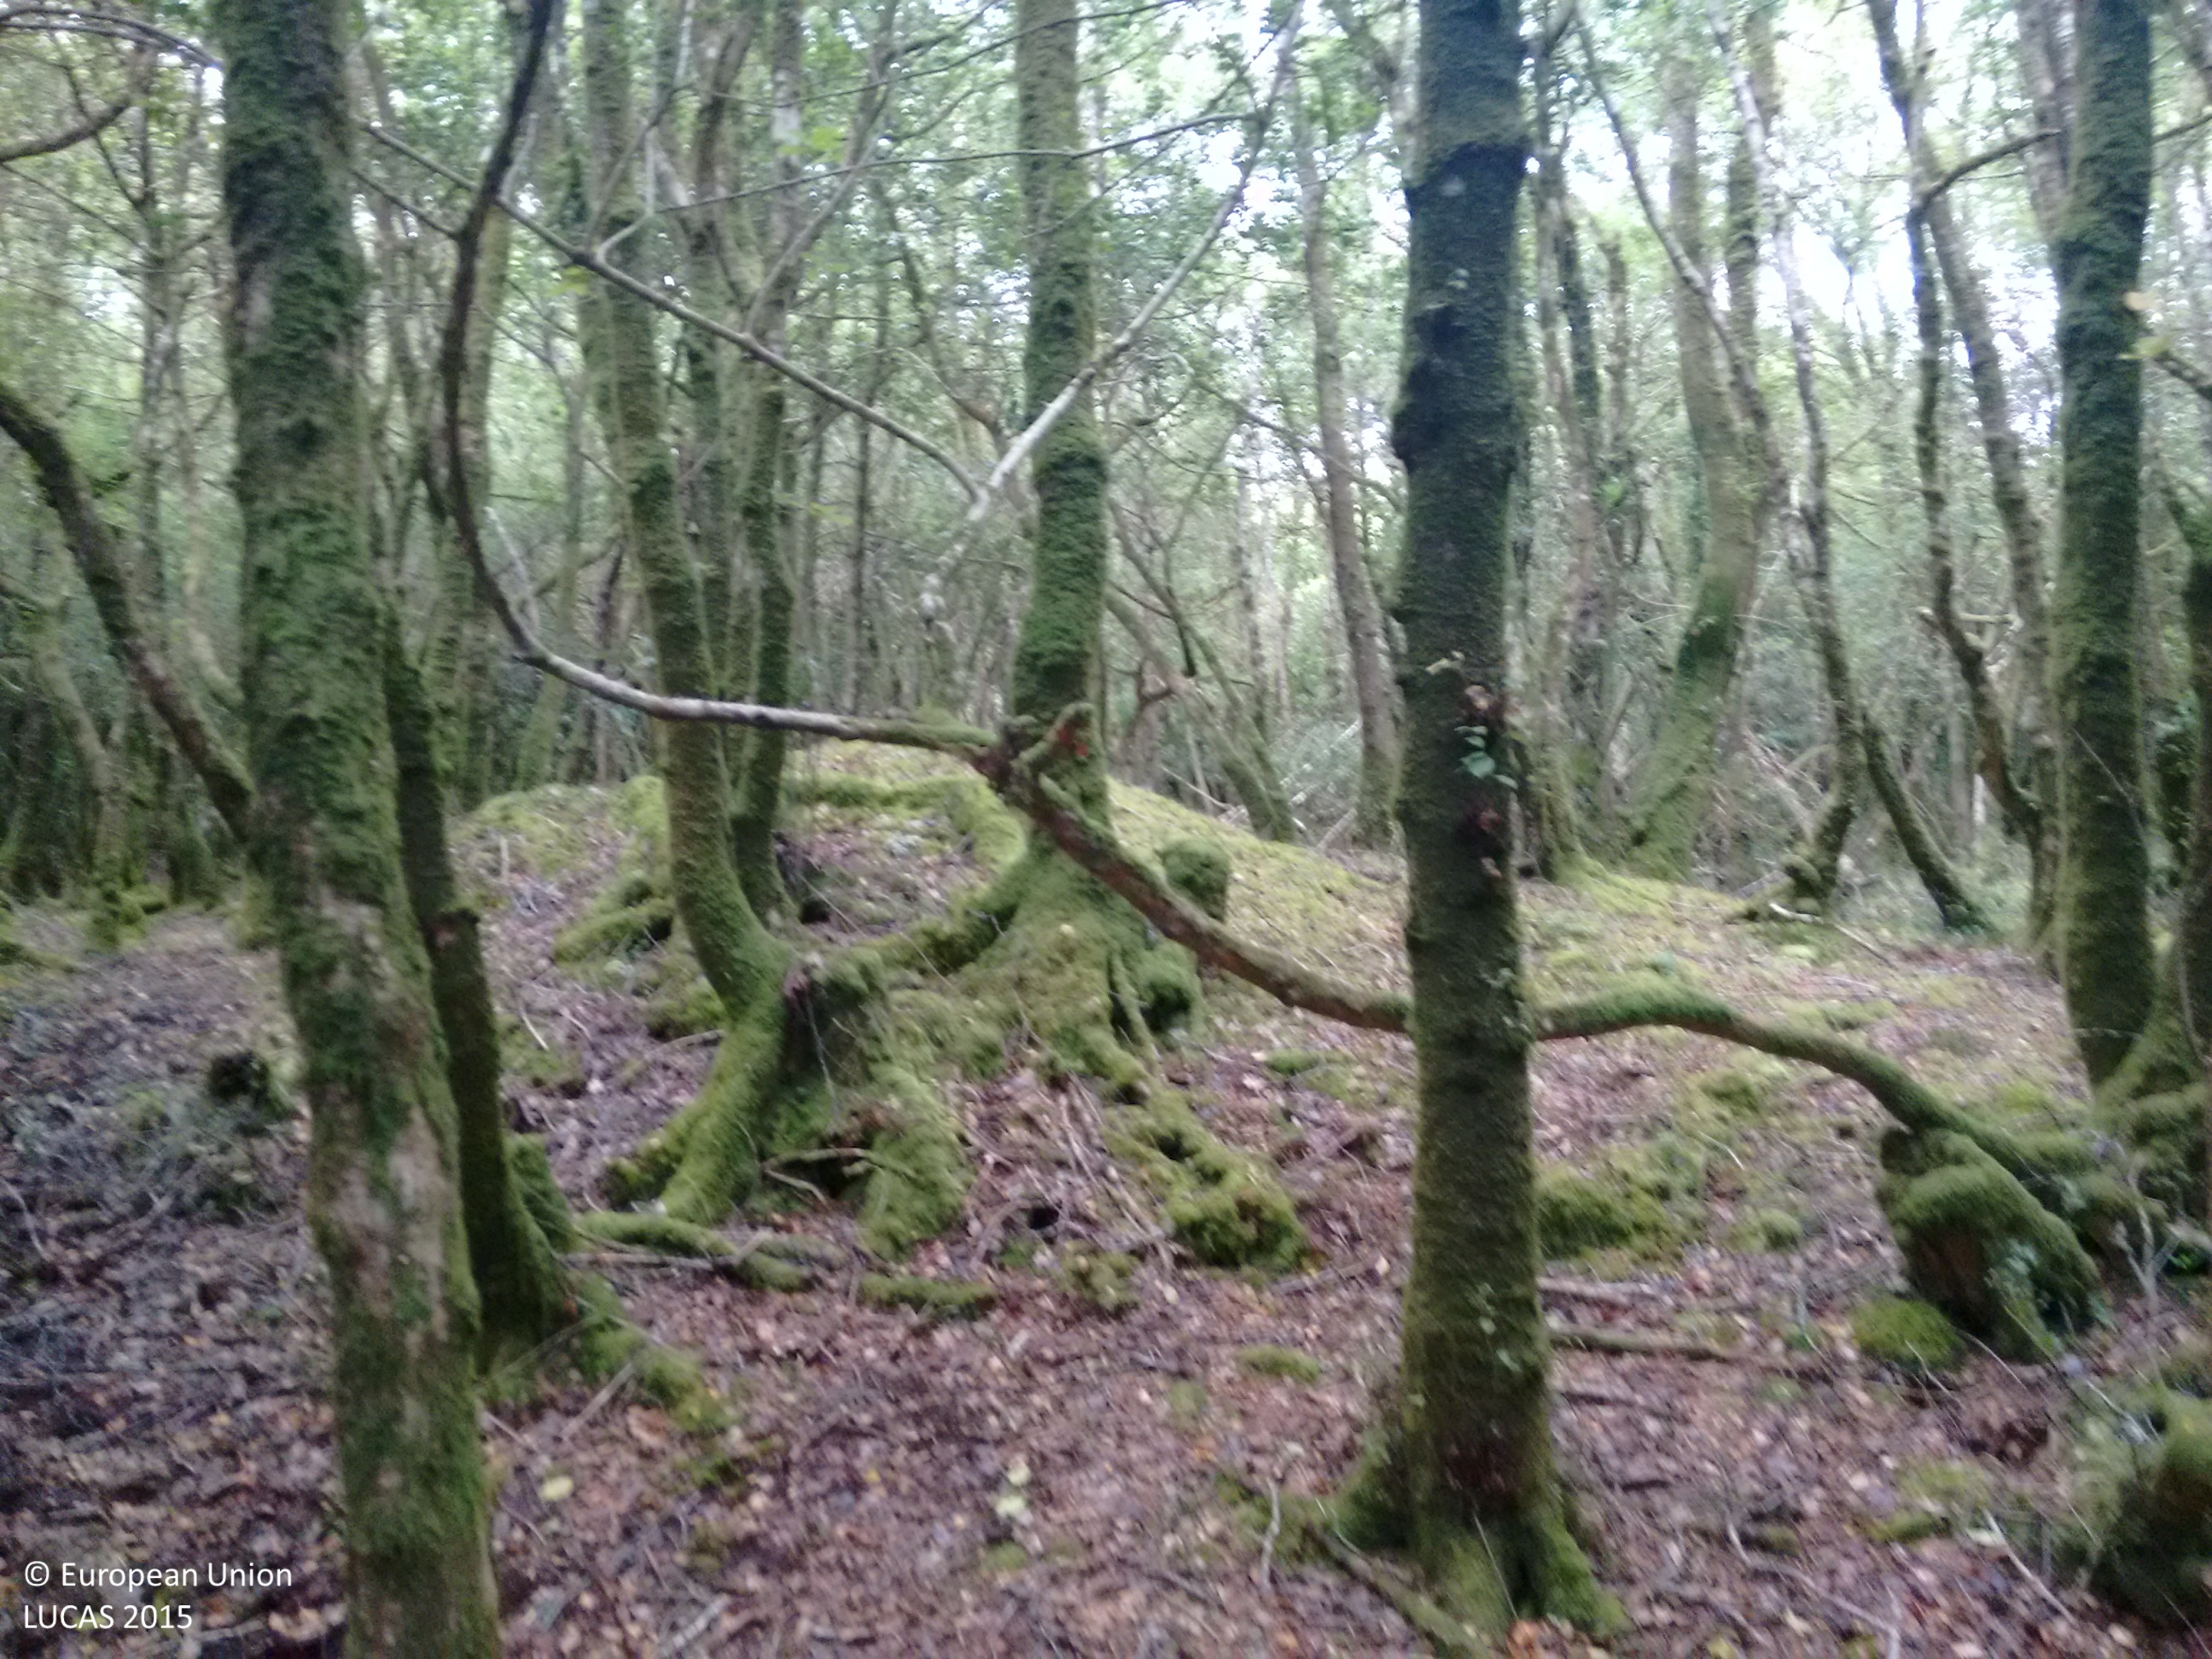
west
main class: Woodland
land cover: Broadleaved woodland
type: acidophilous oak and oak-birch forest
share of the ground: > 75 %
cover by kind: broadleaved forest trees 100 %
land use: Semi-natural and natural areas not in use
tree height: > 5 m
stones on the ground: < 10 %
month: July
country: IE
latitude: 51.7486
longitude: -9.2105
